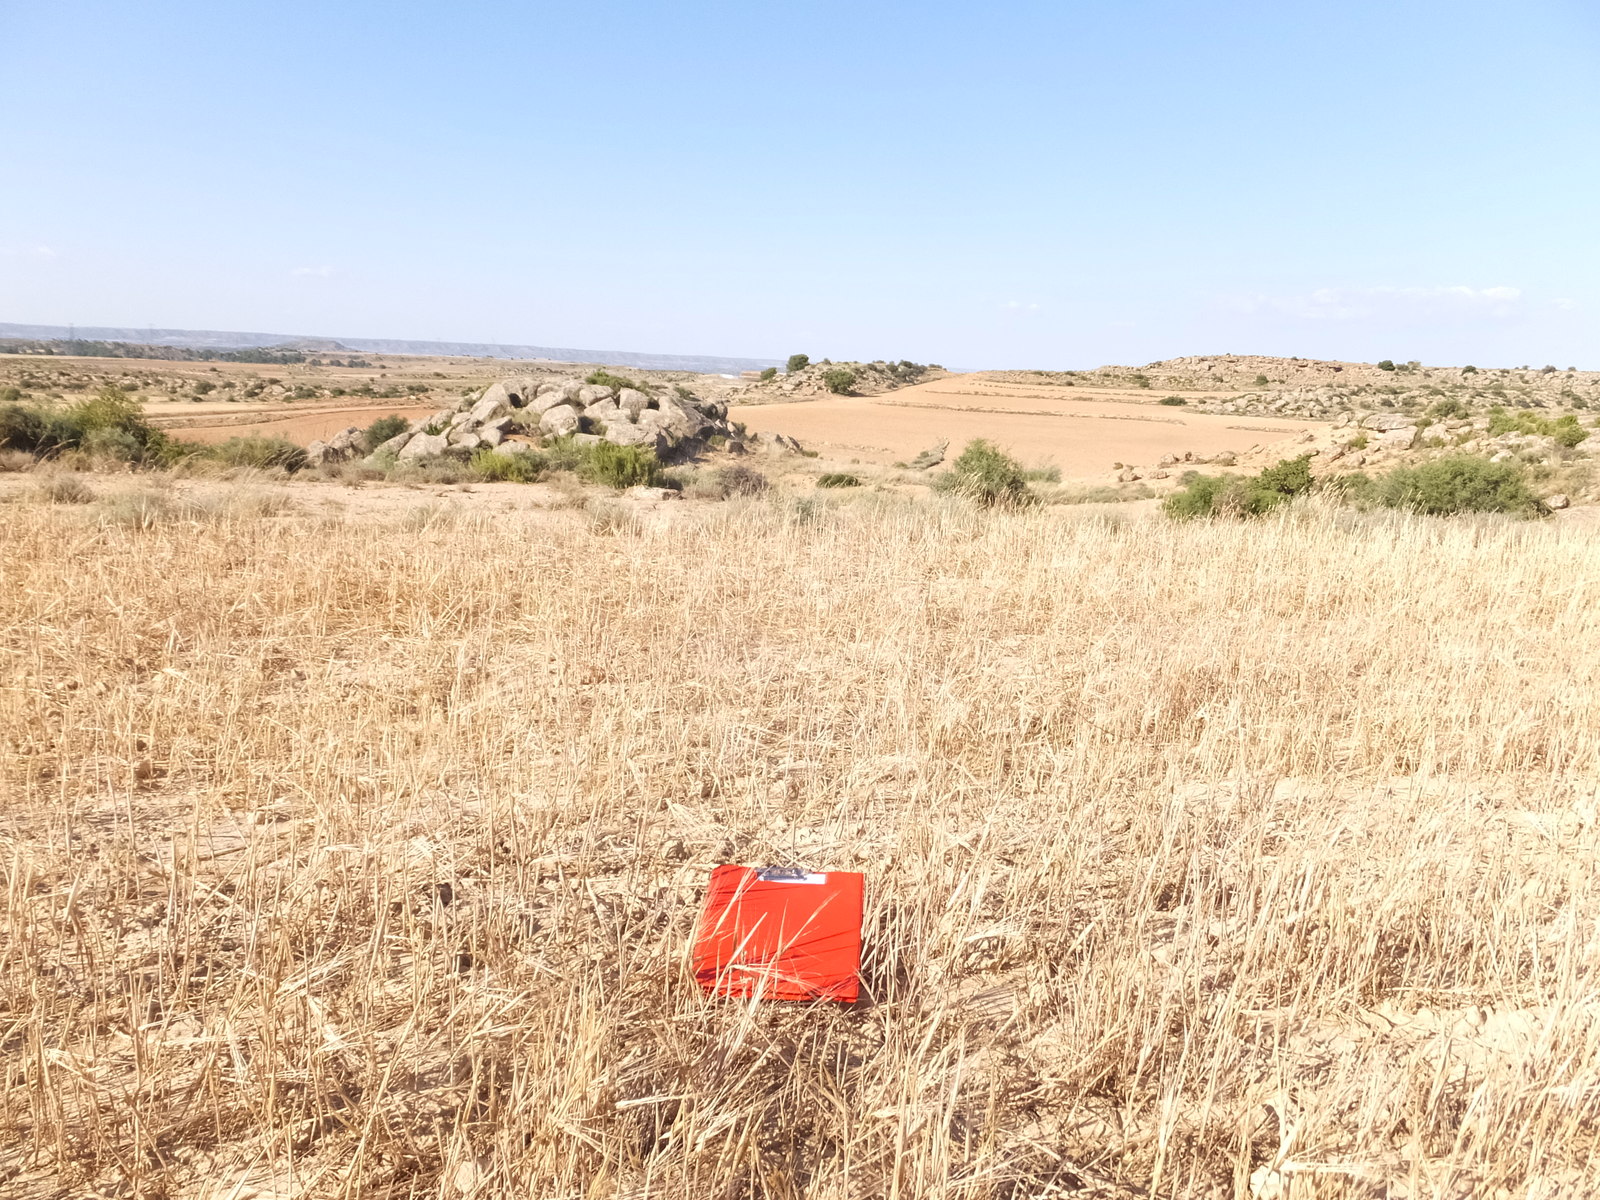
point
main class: Cropland
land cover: Barley
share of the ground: > 75 %
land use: Agriculture (excluding fallow land and kitchen gardens)
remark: Harvested field
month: June
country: ES
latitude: 41.2014
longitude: -0.2809
